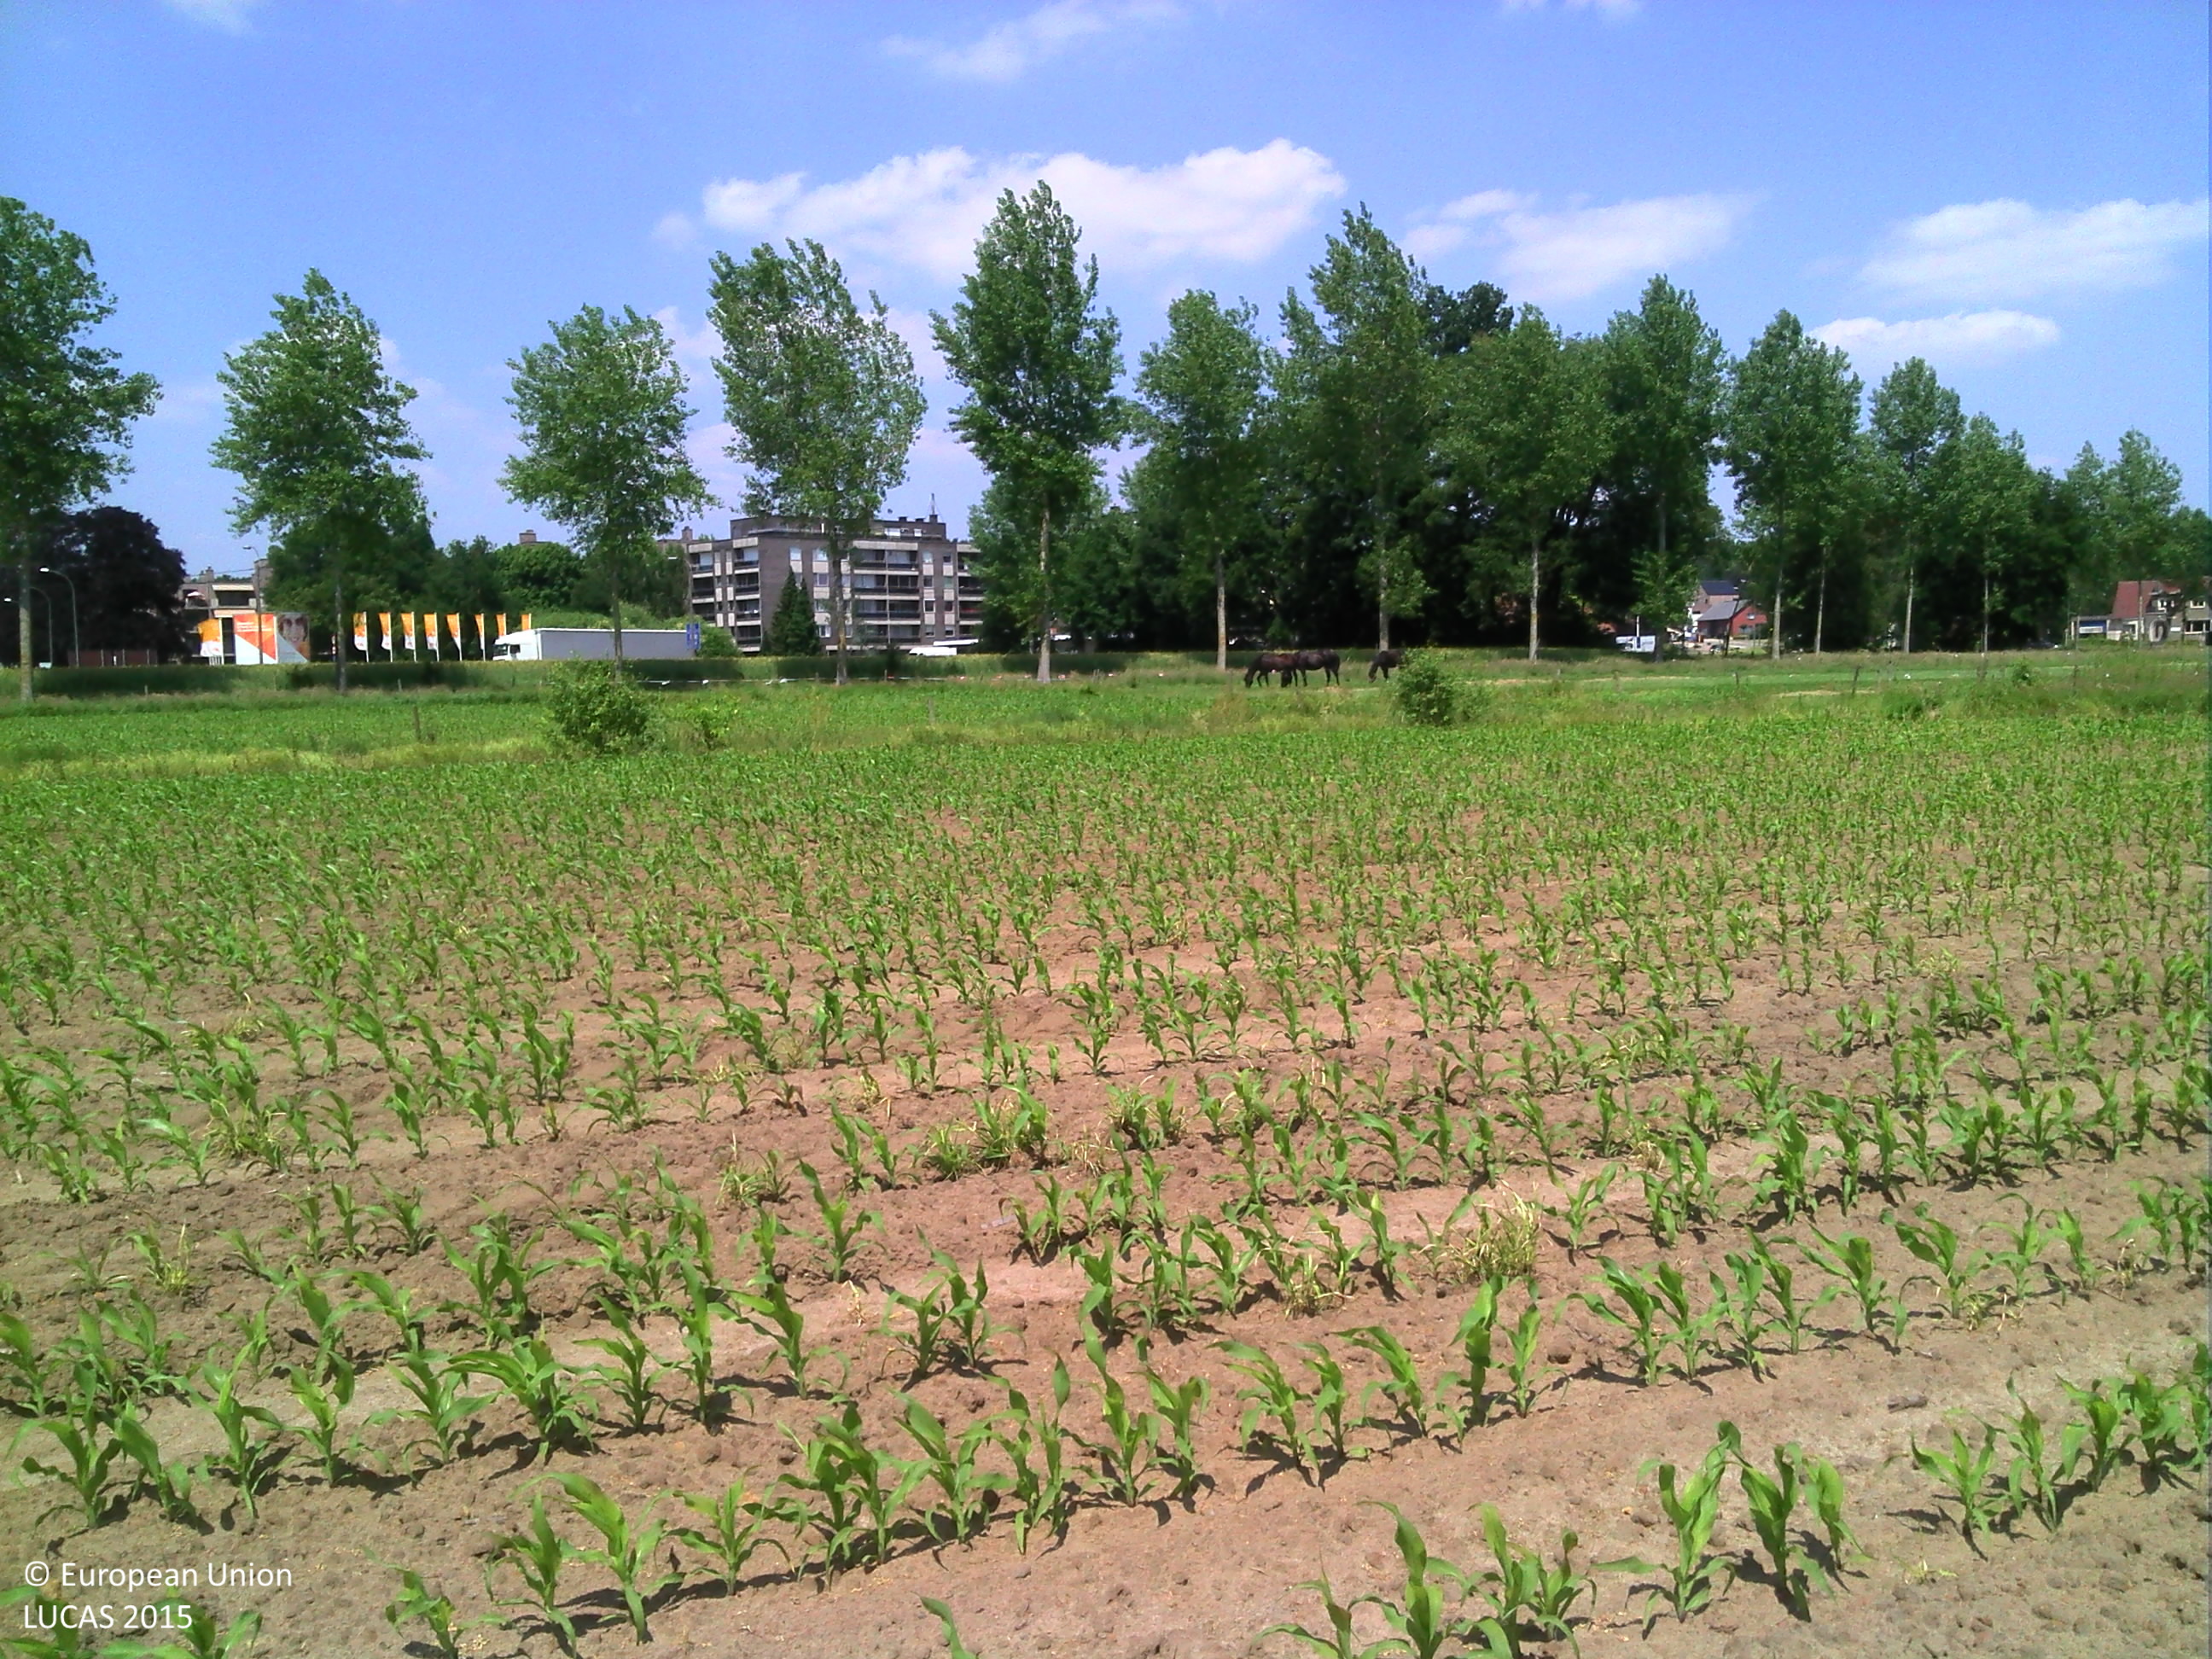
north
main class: Cropland
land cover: Maize
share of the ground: 25 - 50 %
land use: Agriculture (excluding fallow land and kitchen gardens)
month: June
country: BE
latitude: 50.9837
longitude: 5.1971
